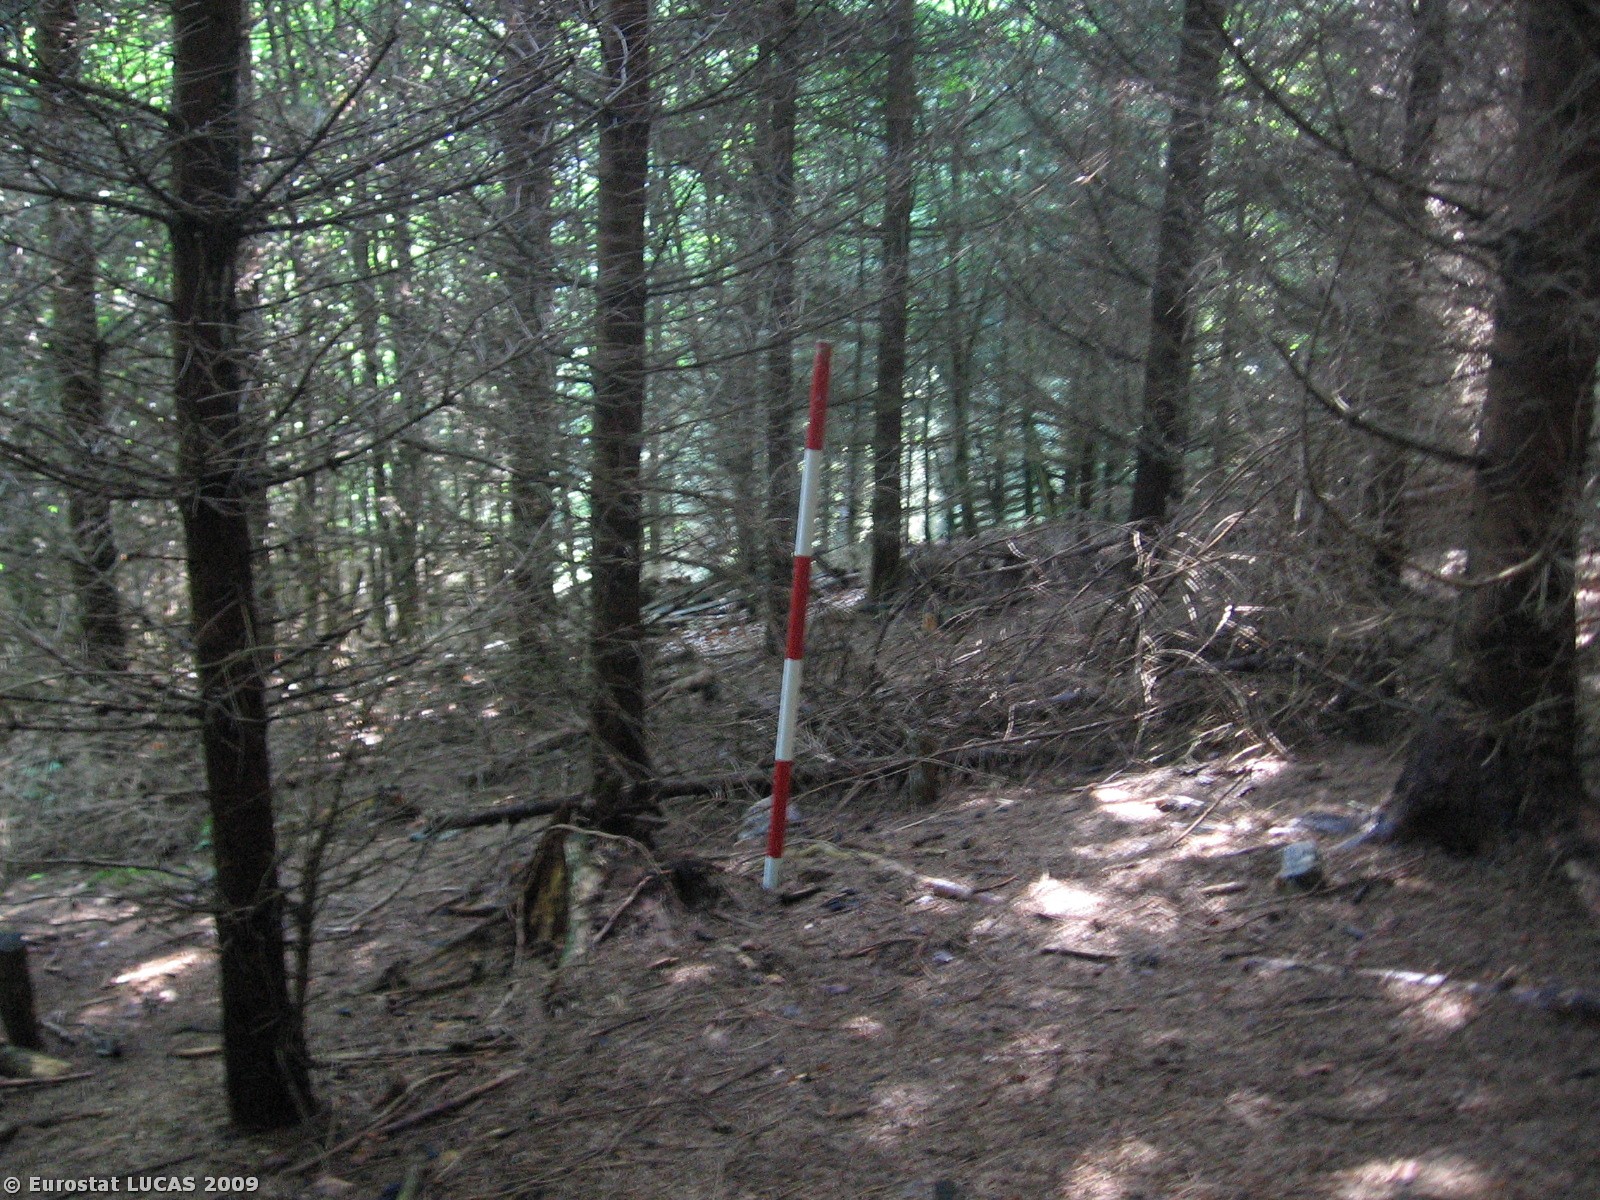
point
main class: Woodland
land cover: Coniferous woodland
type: hemiboreal forest and nemoral coniferous forest and mixed broadleaved-coniferous forest
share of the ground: > 75 %
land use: Forestry
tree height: > 5 m
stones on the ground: < 10 %
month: July
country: CZ
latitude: 49.2582
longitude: 13.1738
